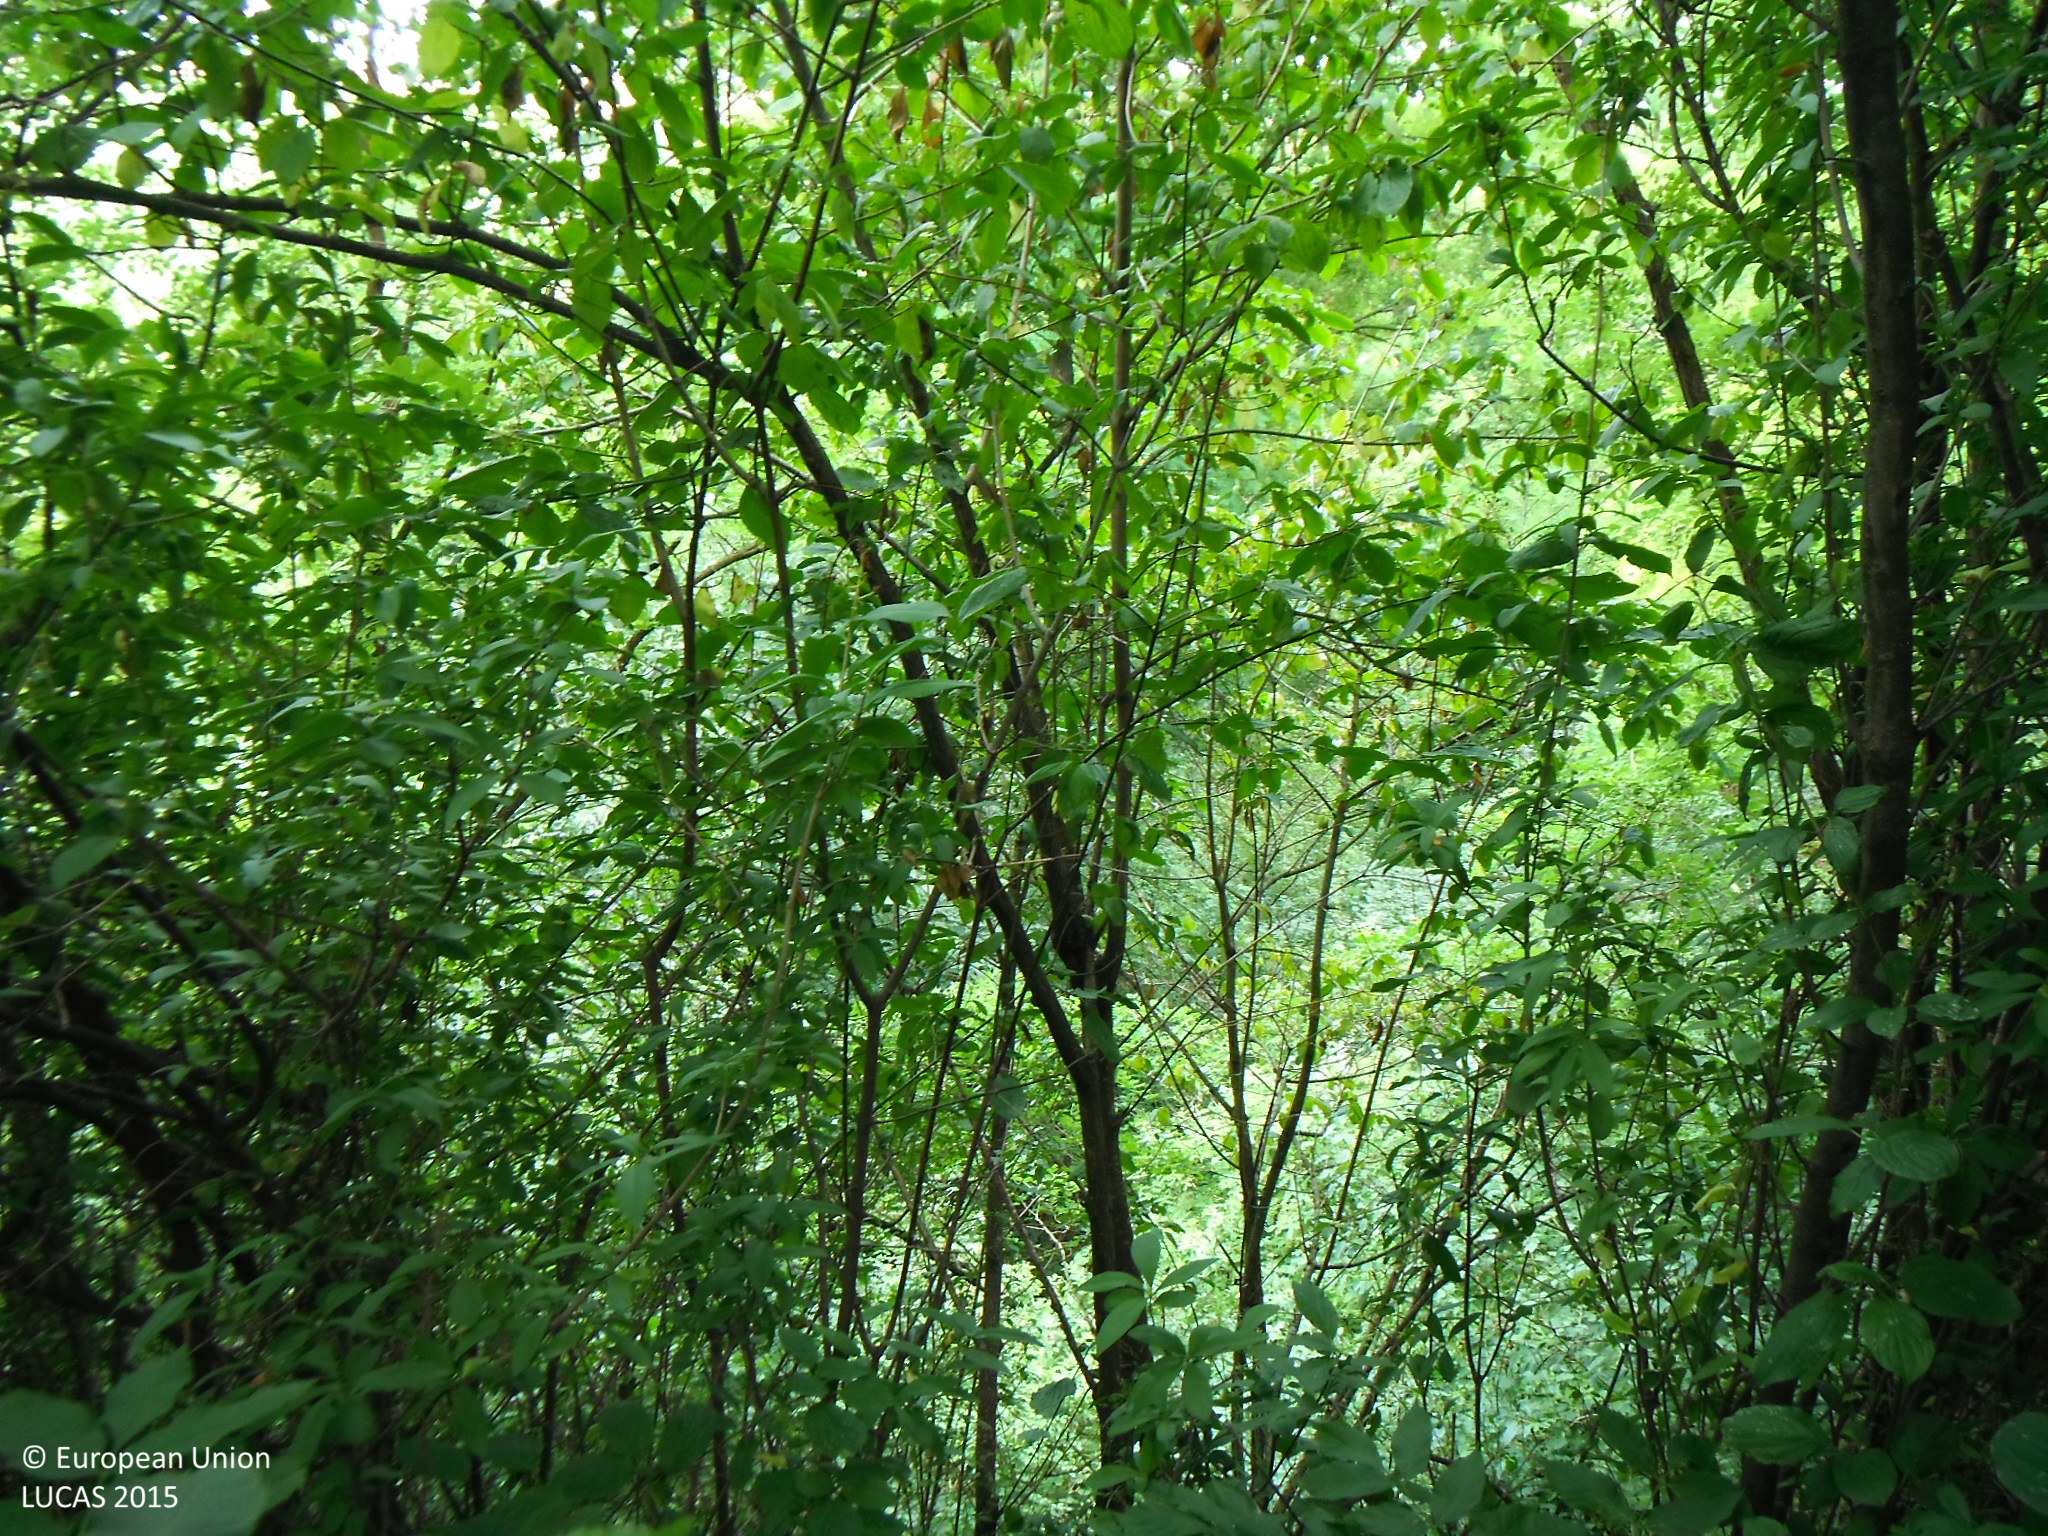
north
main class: Woodland
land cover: Broadleaved woodland
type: mesophytic deciduous forest
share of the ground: > 75 %
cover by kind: broadleaved forest trees 75 %, shrubs 25 %
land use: Semi-natural and natural areas not in use
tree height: > 5 m
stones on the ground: < 10 %
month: July
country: SK
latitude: 48.7888
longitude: 21.4397
